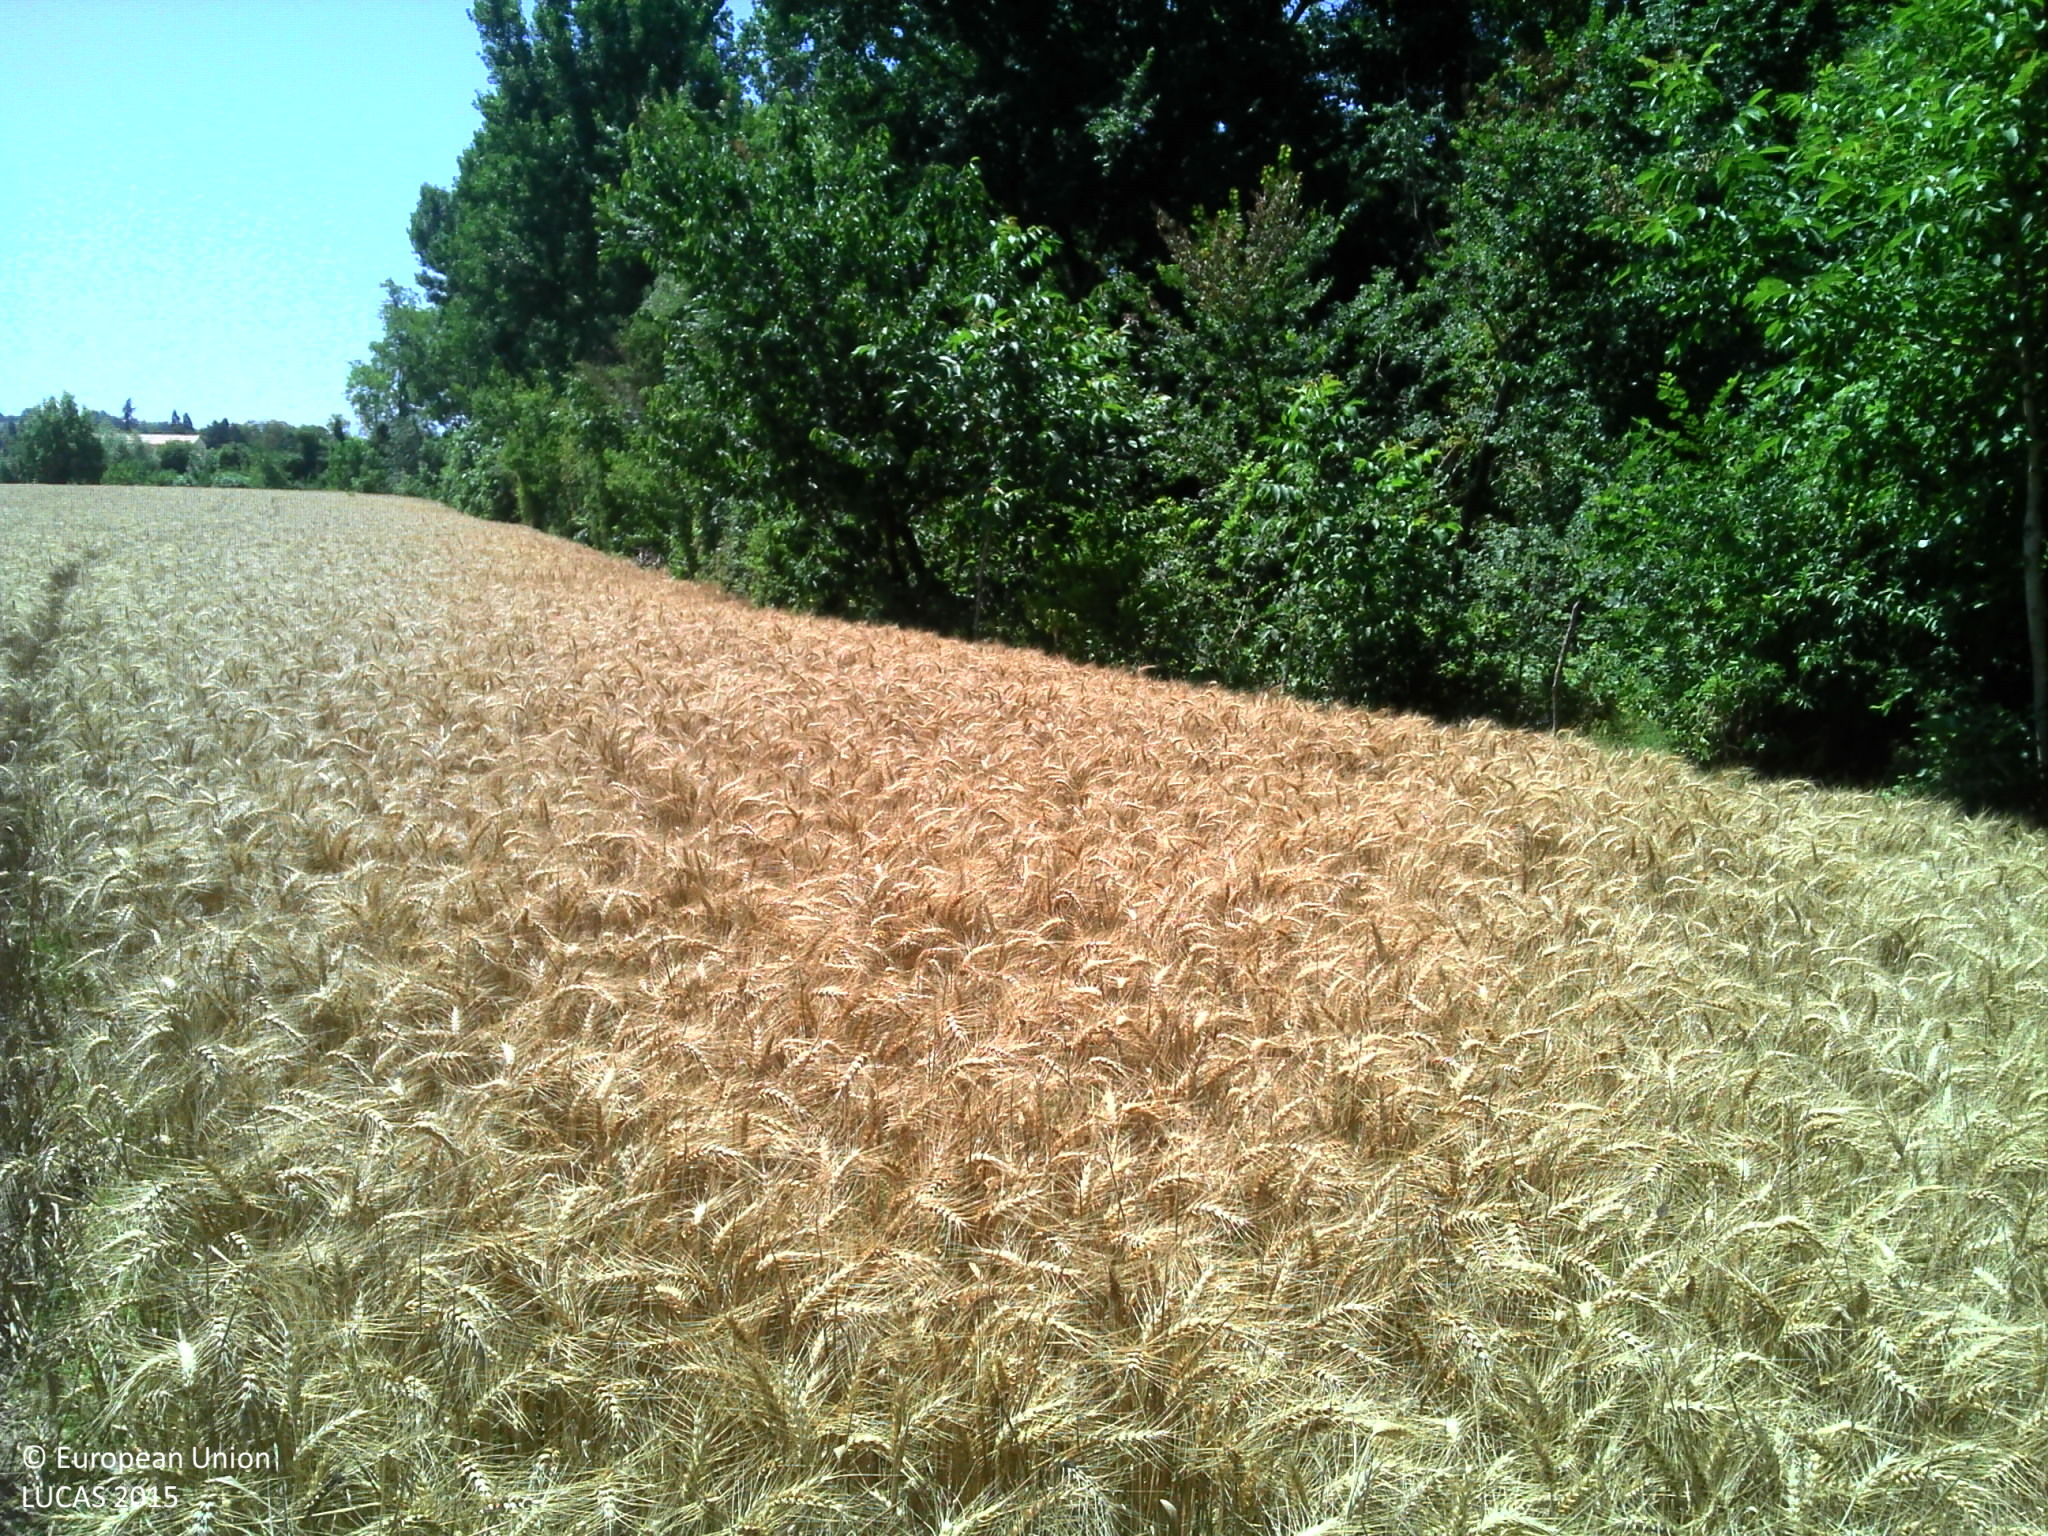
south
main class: Cropland
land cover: Durum wheat
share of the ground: > 75 %
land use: Agriculture (excluding fallow land and kitchen gardens)
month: June
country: FR
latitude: 43.2057
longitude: 1.7475
